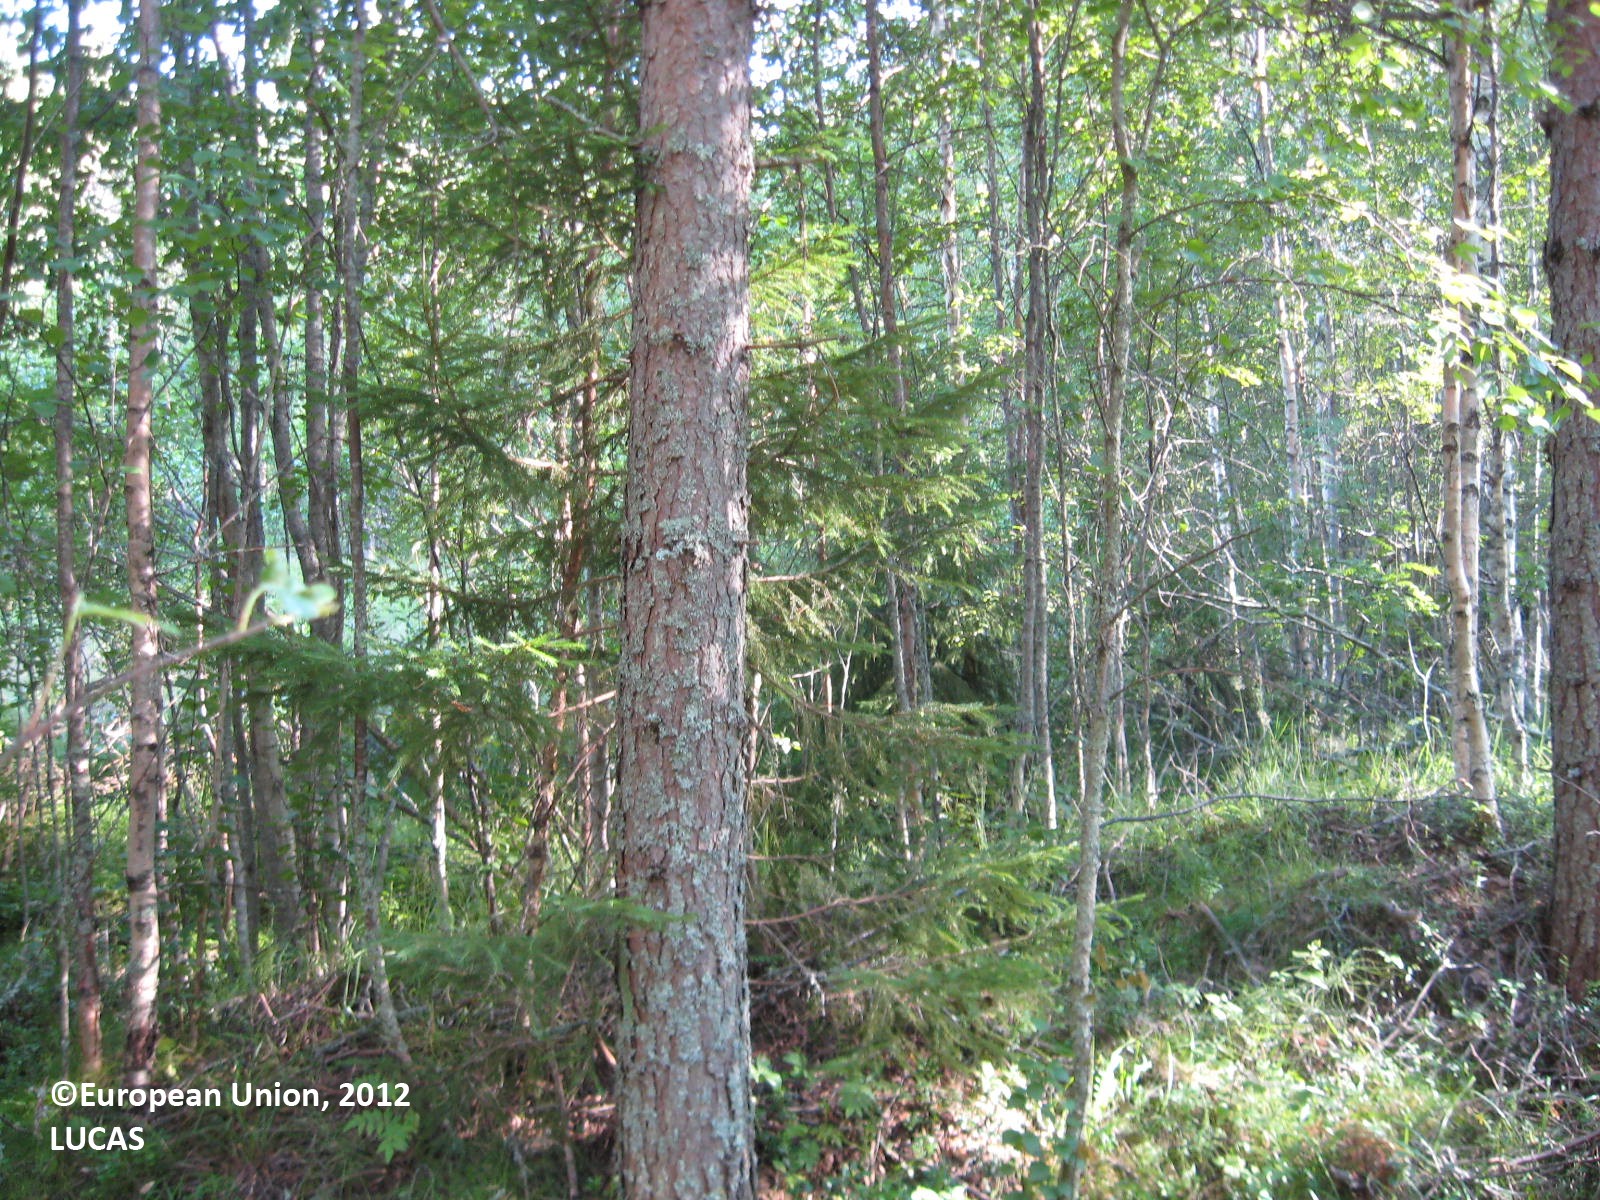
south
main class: Woodland
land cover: Pine dominated mixed woodland
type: boreal forest
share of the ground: > 75 %
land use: Forestry
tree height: > 5 m
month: July
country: FI
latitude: 61.9504
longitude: 22.6242
